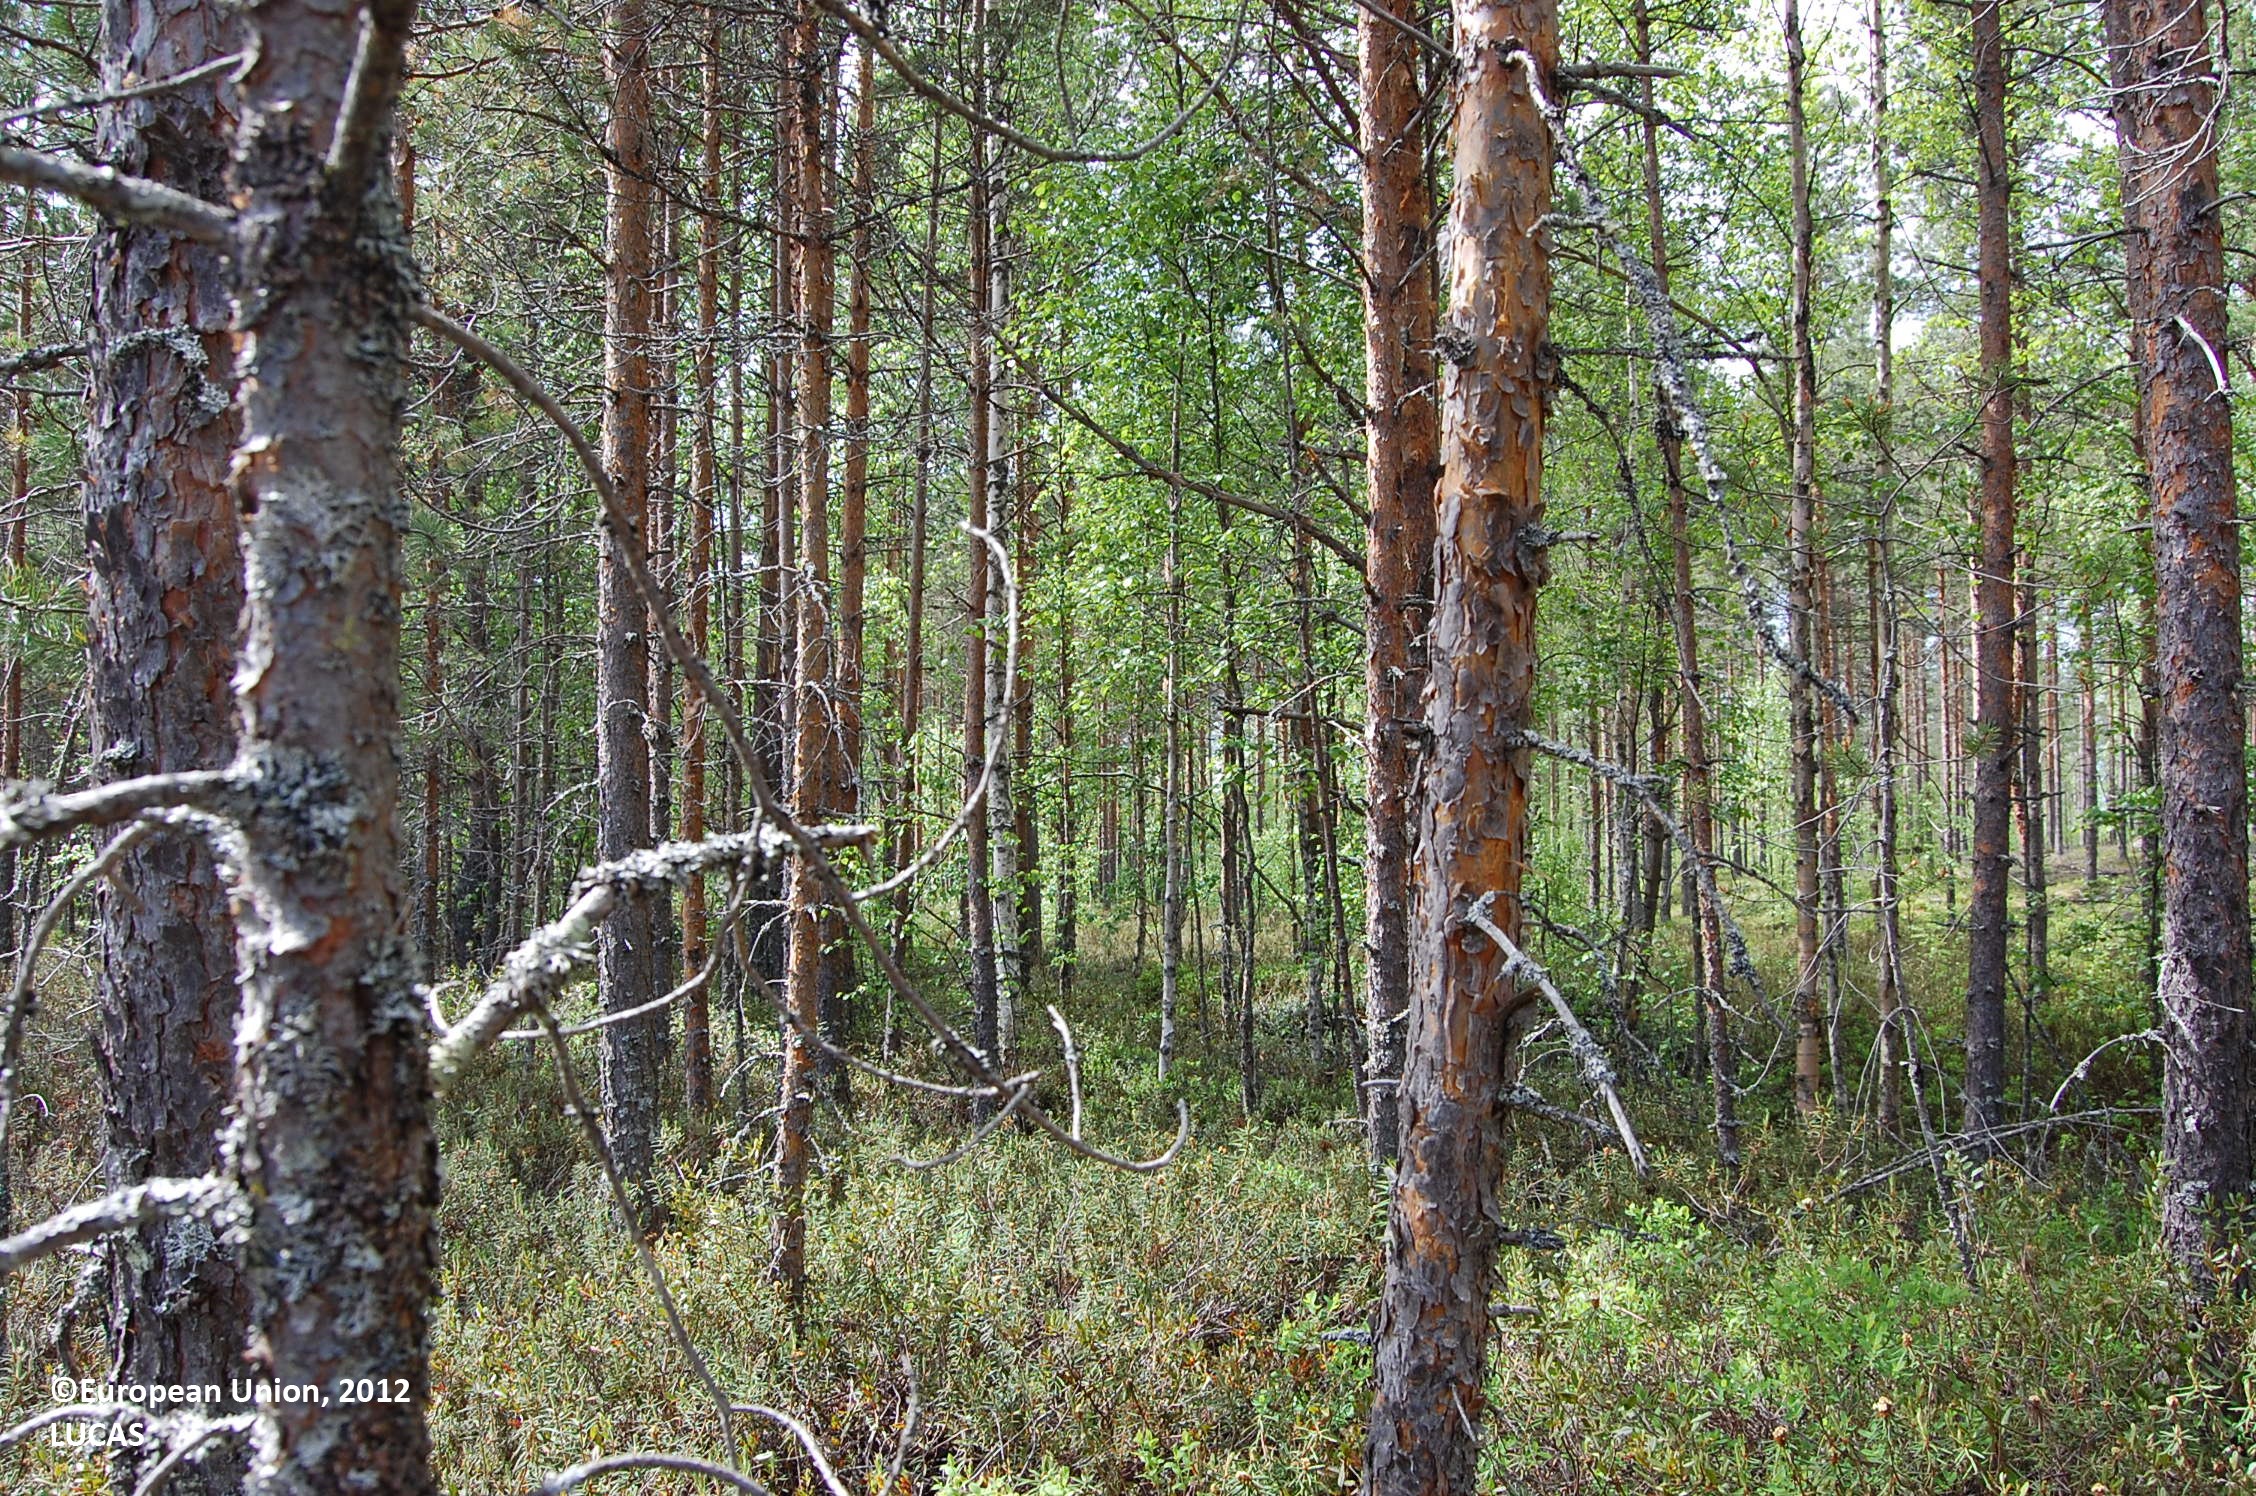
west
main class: Woodland
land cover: Pine dominated coniferous woodland
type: hemiboreal forest and nemoral coniferous forest and mixed broadleaved-coniferous forest
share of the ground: > 75 %
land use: Forestry
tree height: > 5 m
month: June
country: FI
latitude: 64.1278
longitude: 26.2358
